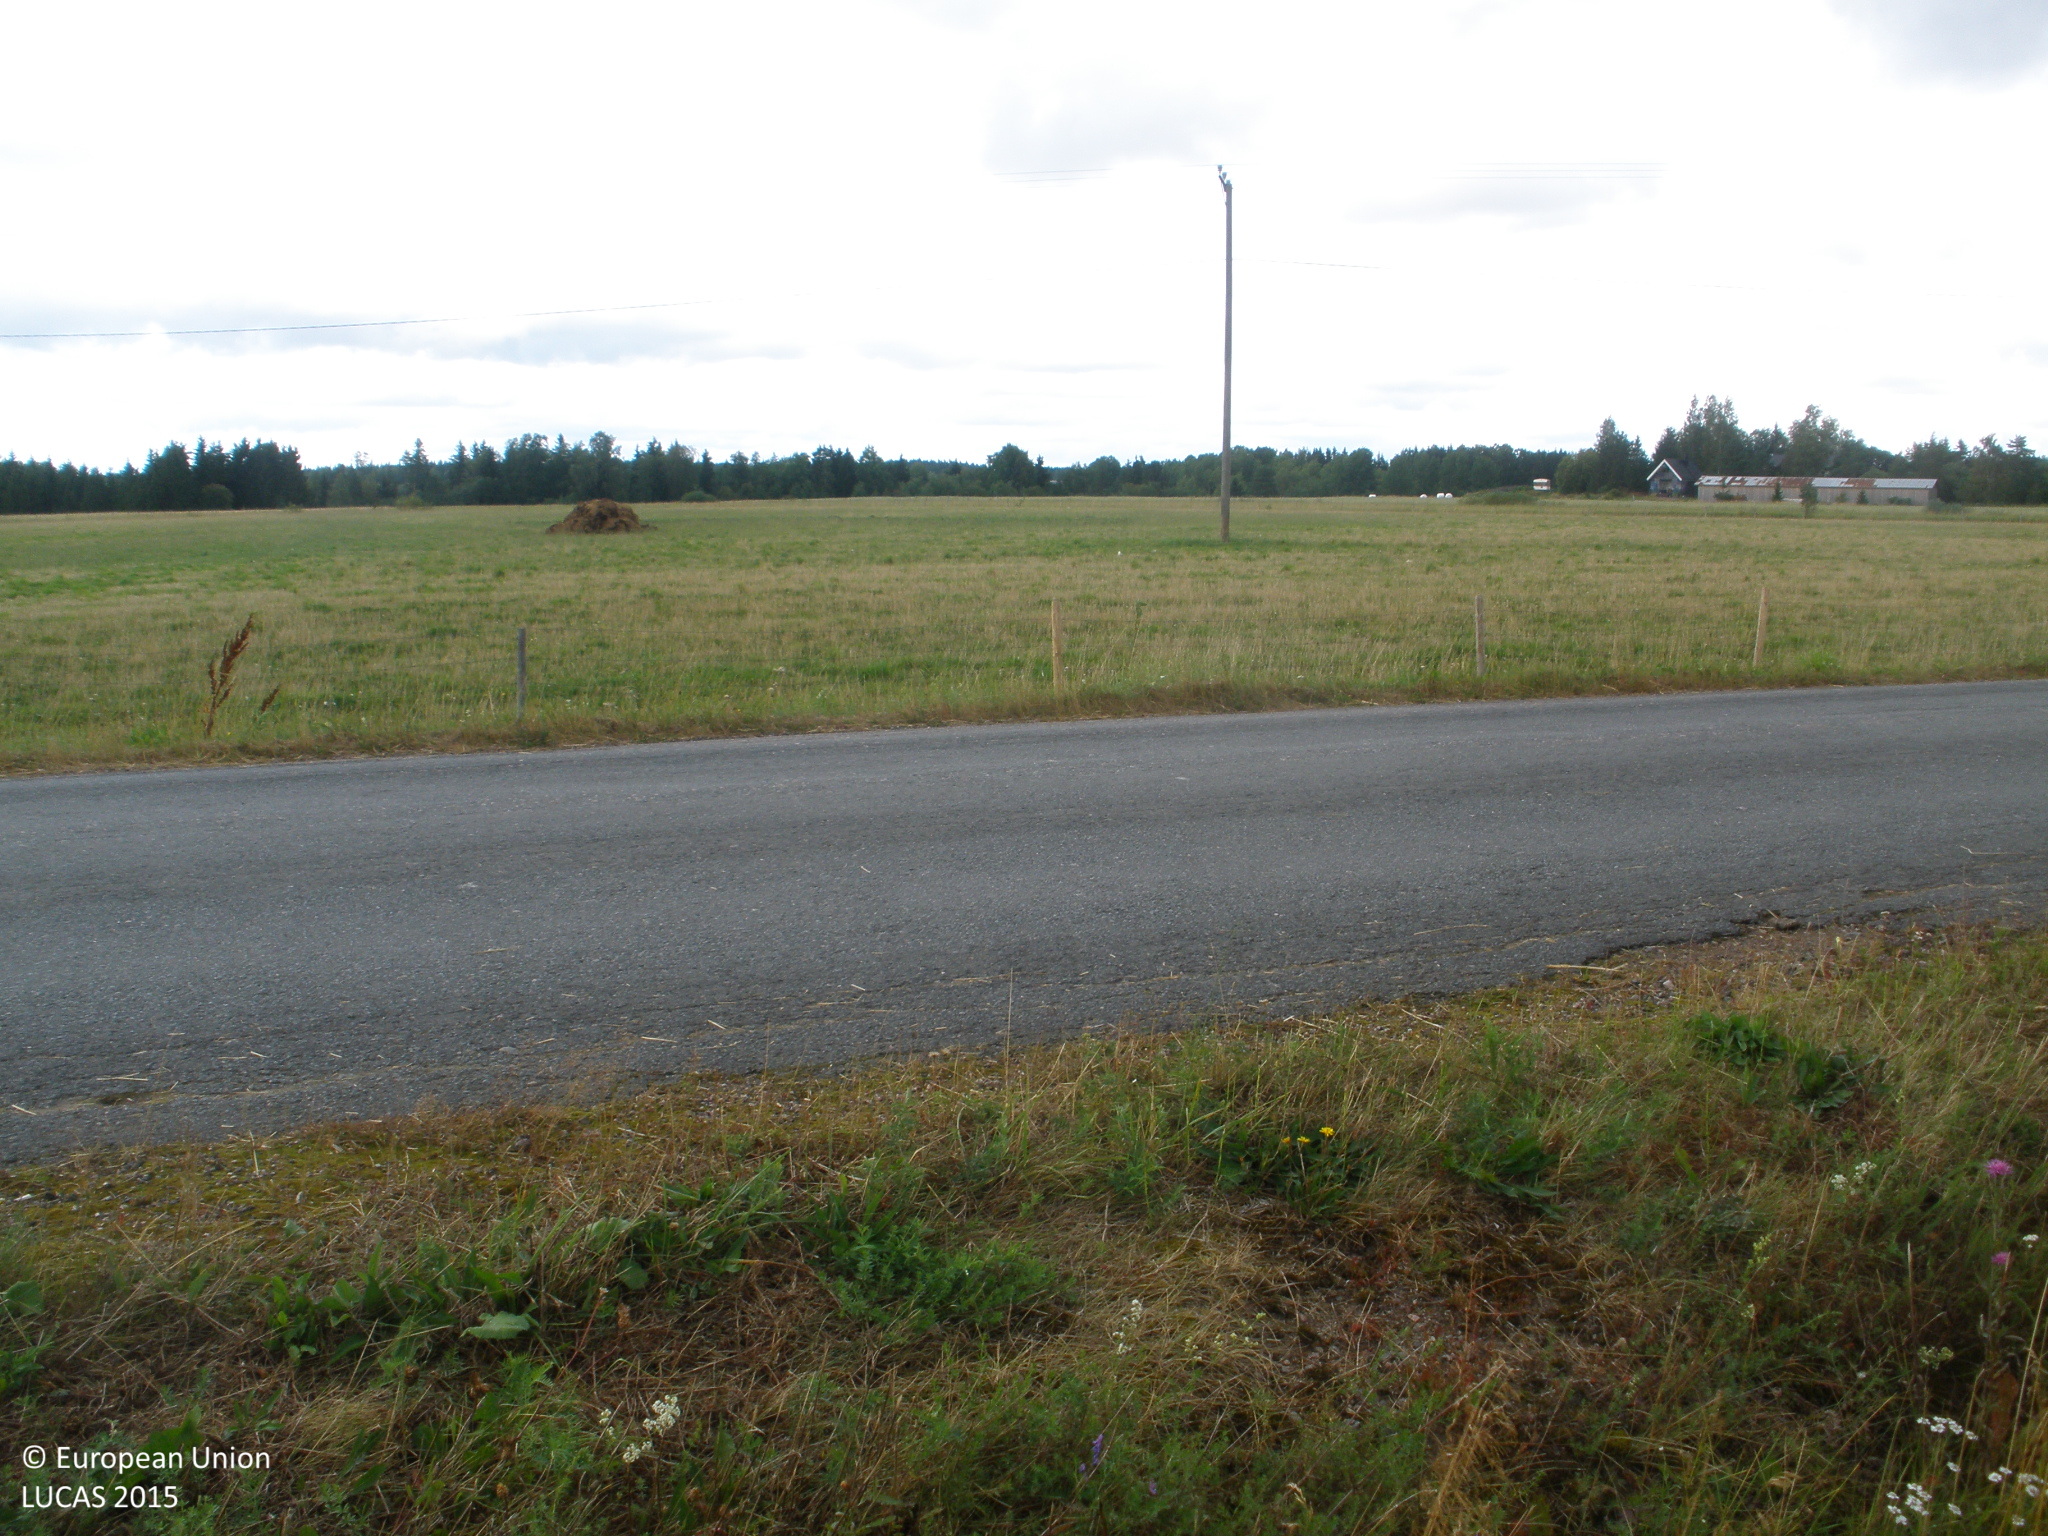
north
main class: Cropland
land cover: Barley
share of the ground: 50 - 75 %
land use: Agriculture (excluding fallow land and kitchen gardens)
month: August
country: FI
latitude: 60.5817
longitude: 23.3894
